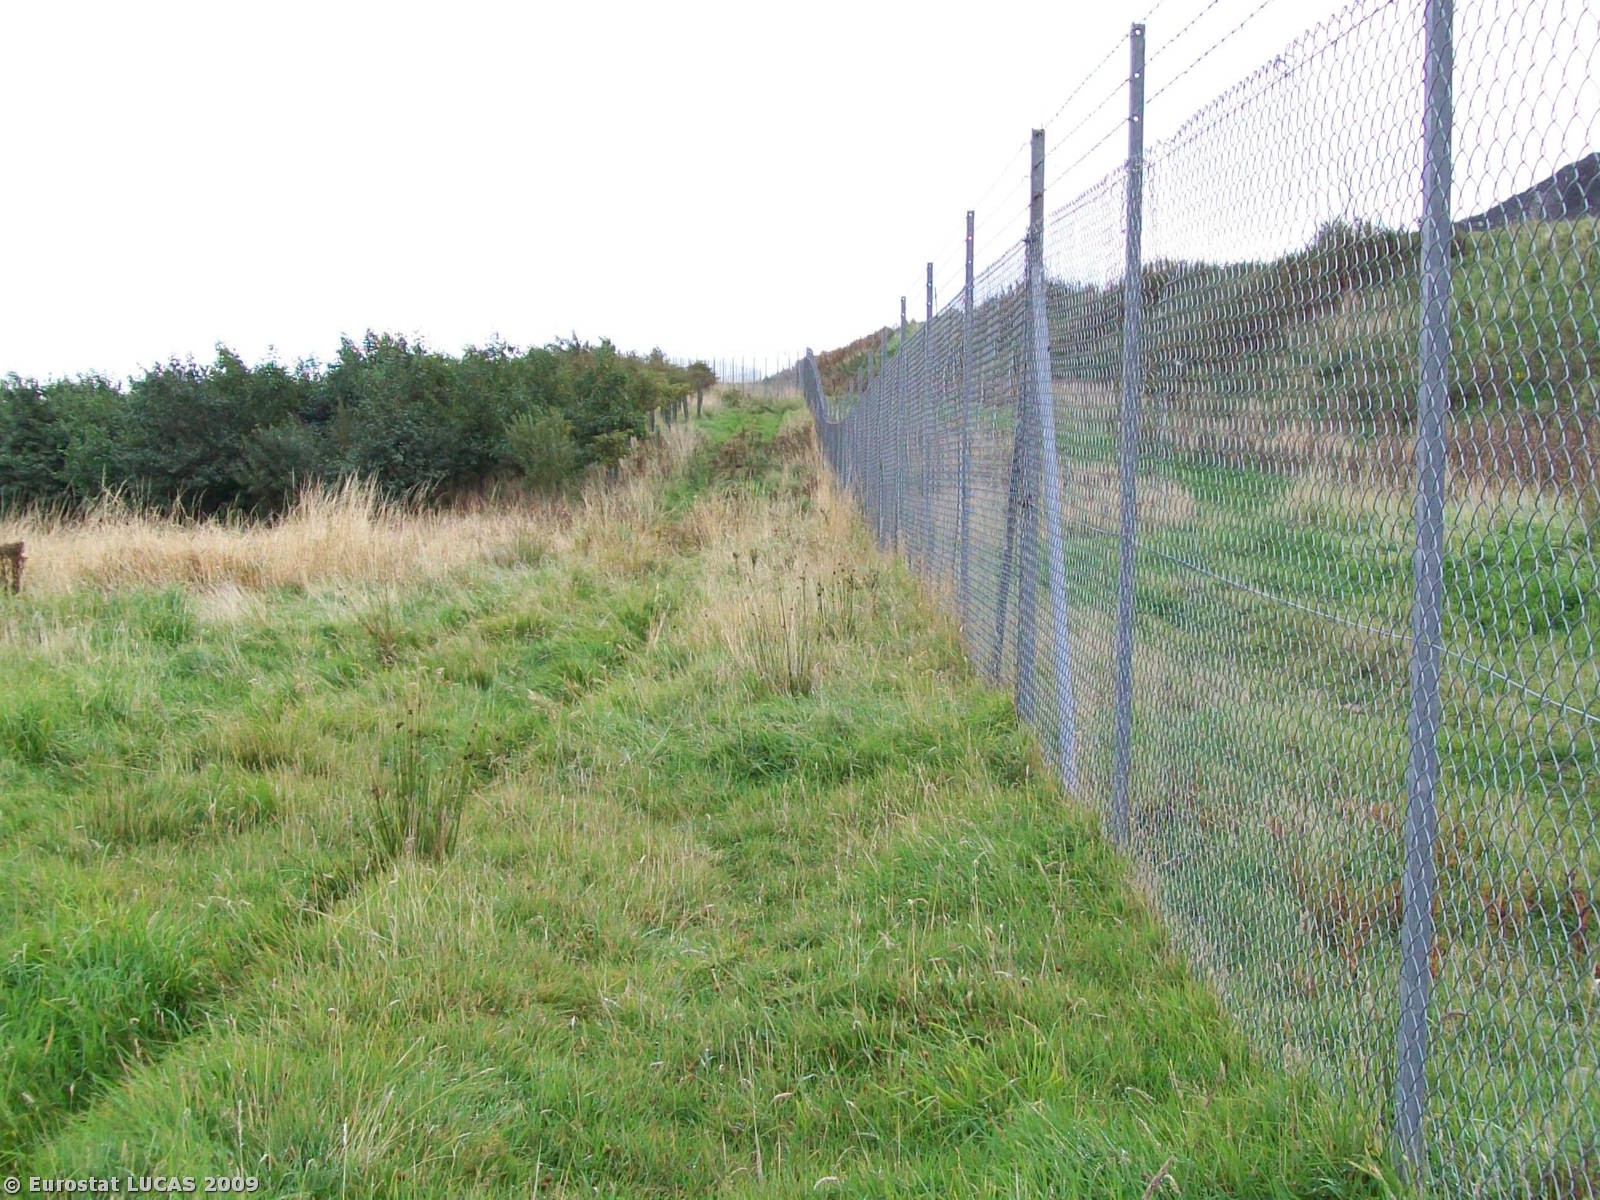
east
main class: Grassland
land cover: Spontaneously vegetated surfaces
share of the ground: > 75 %
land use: Fallow land
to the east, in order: Spontaneously vegetated surfaces; Grassland without tree/shrub cover; Shrubland without tree cover; Grassland without tree/shrub cover; Fences; Rock outcrops; Artificial constructions in urban areas
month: September
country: GB
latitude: 57.2370
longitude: -2.0591
